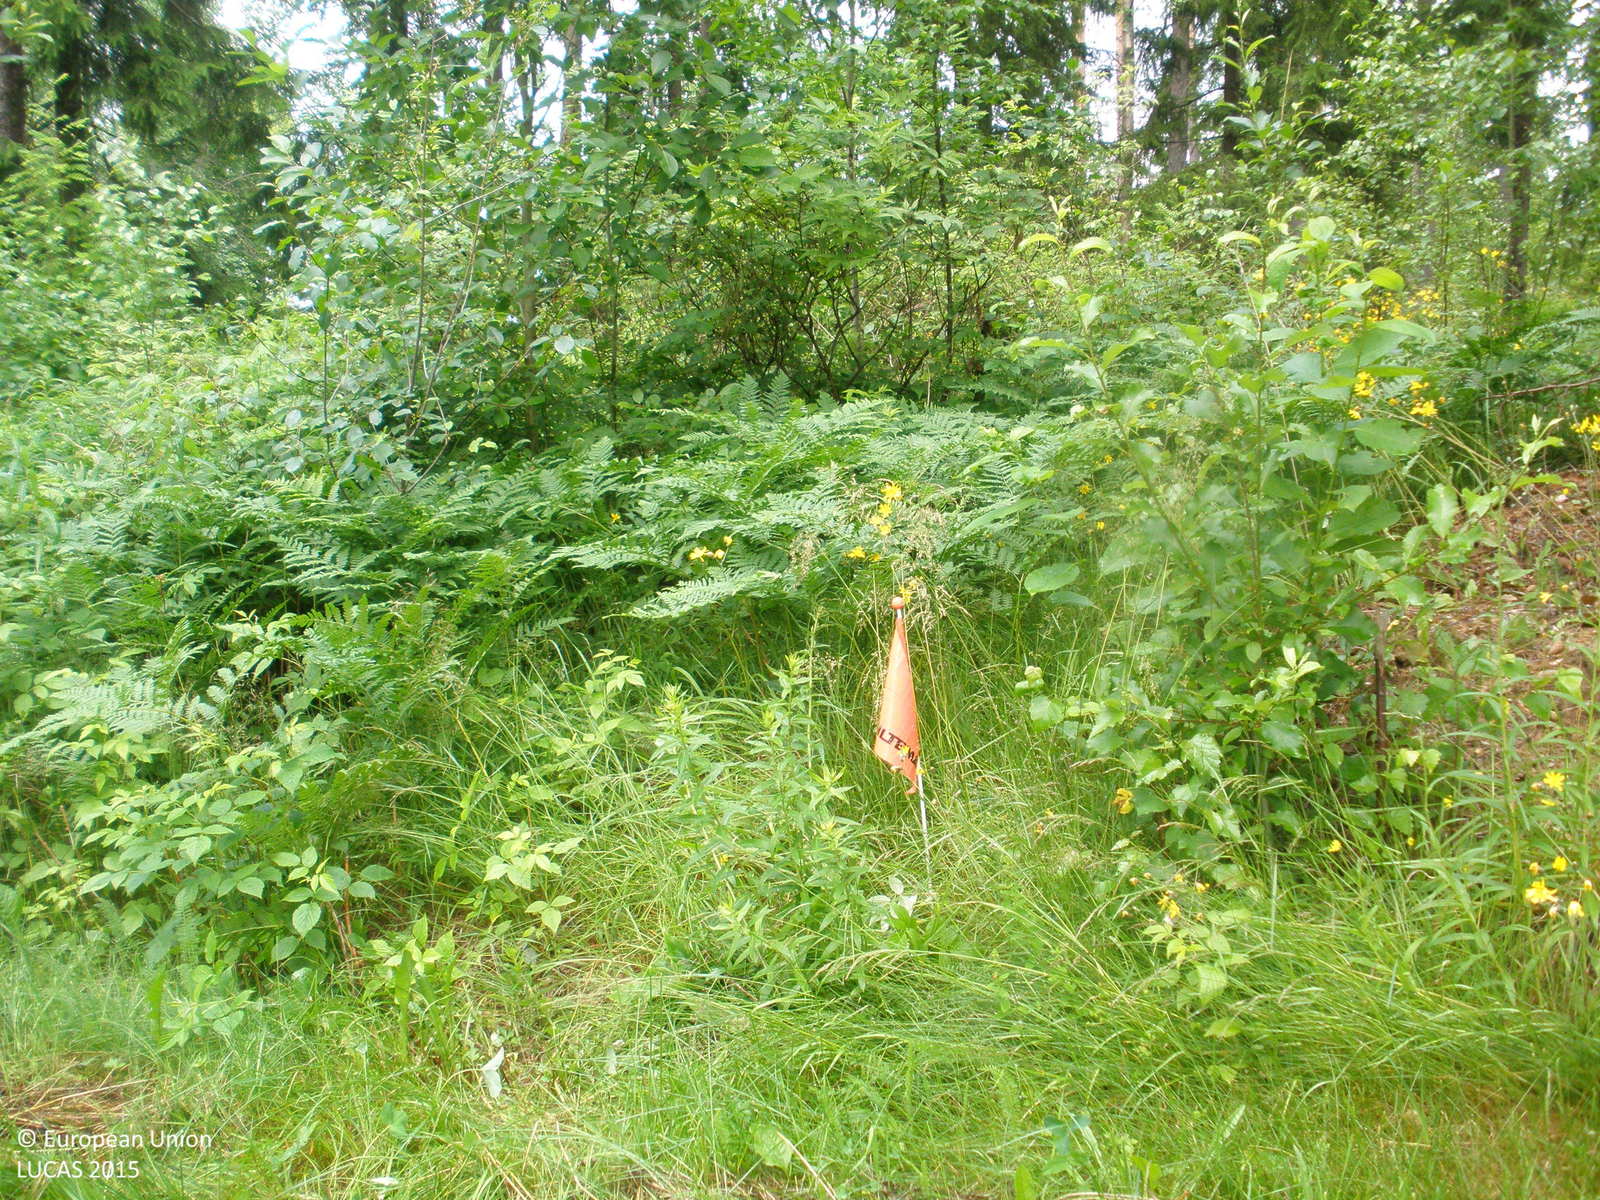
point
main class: Shrubland
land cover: Shrubland with sparse tree cover
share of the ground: > 75 %
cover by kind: shrubs 85 %, broadleaved forest trees 5 %, herbaceous plants 5 %, lichens and mosses 5 %
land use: Forestry
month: July
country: FI
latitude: 61.2442
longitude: 23.7445
